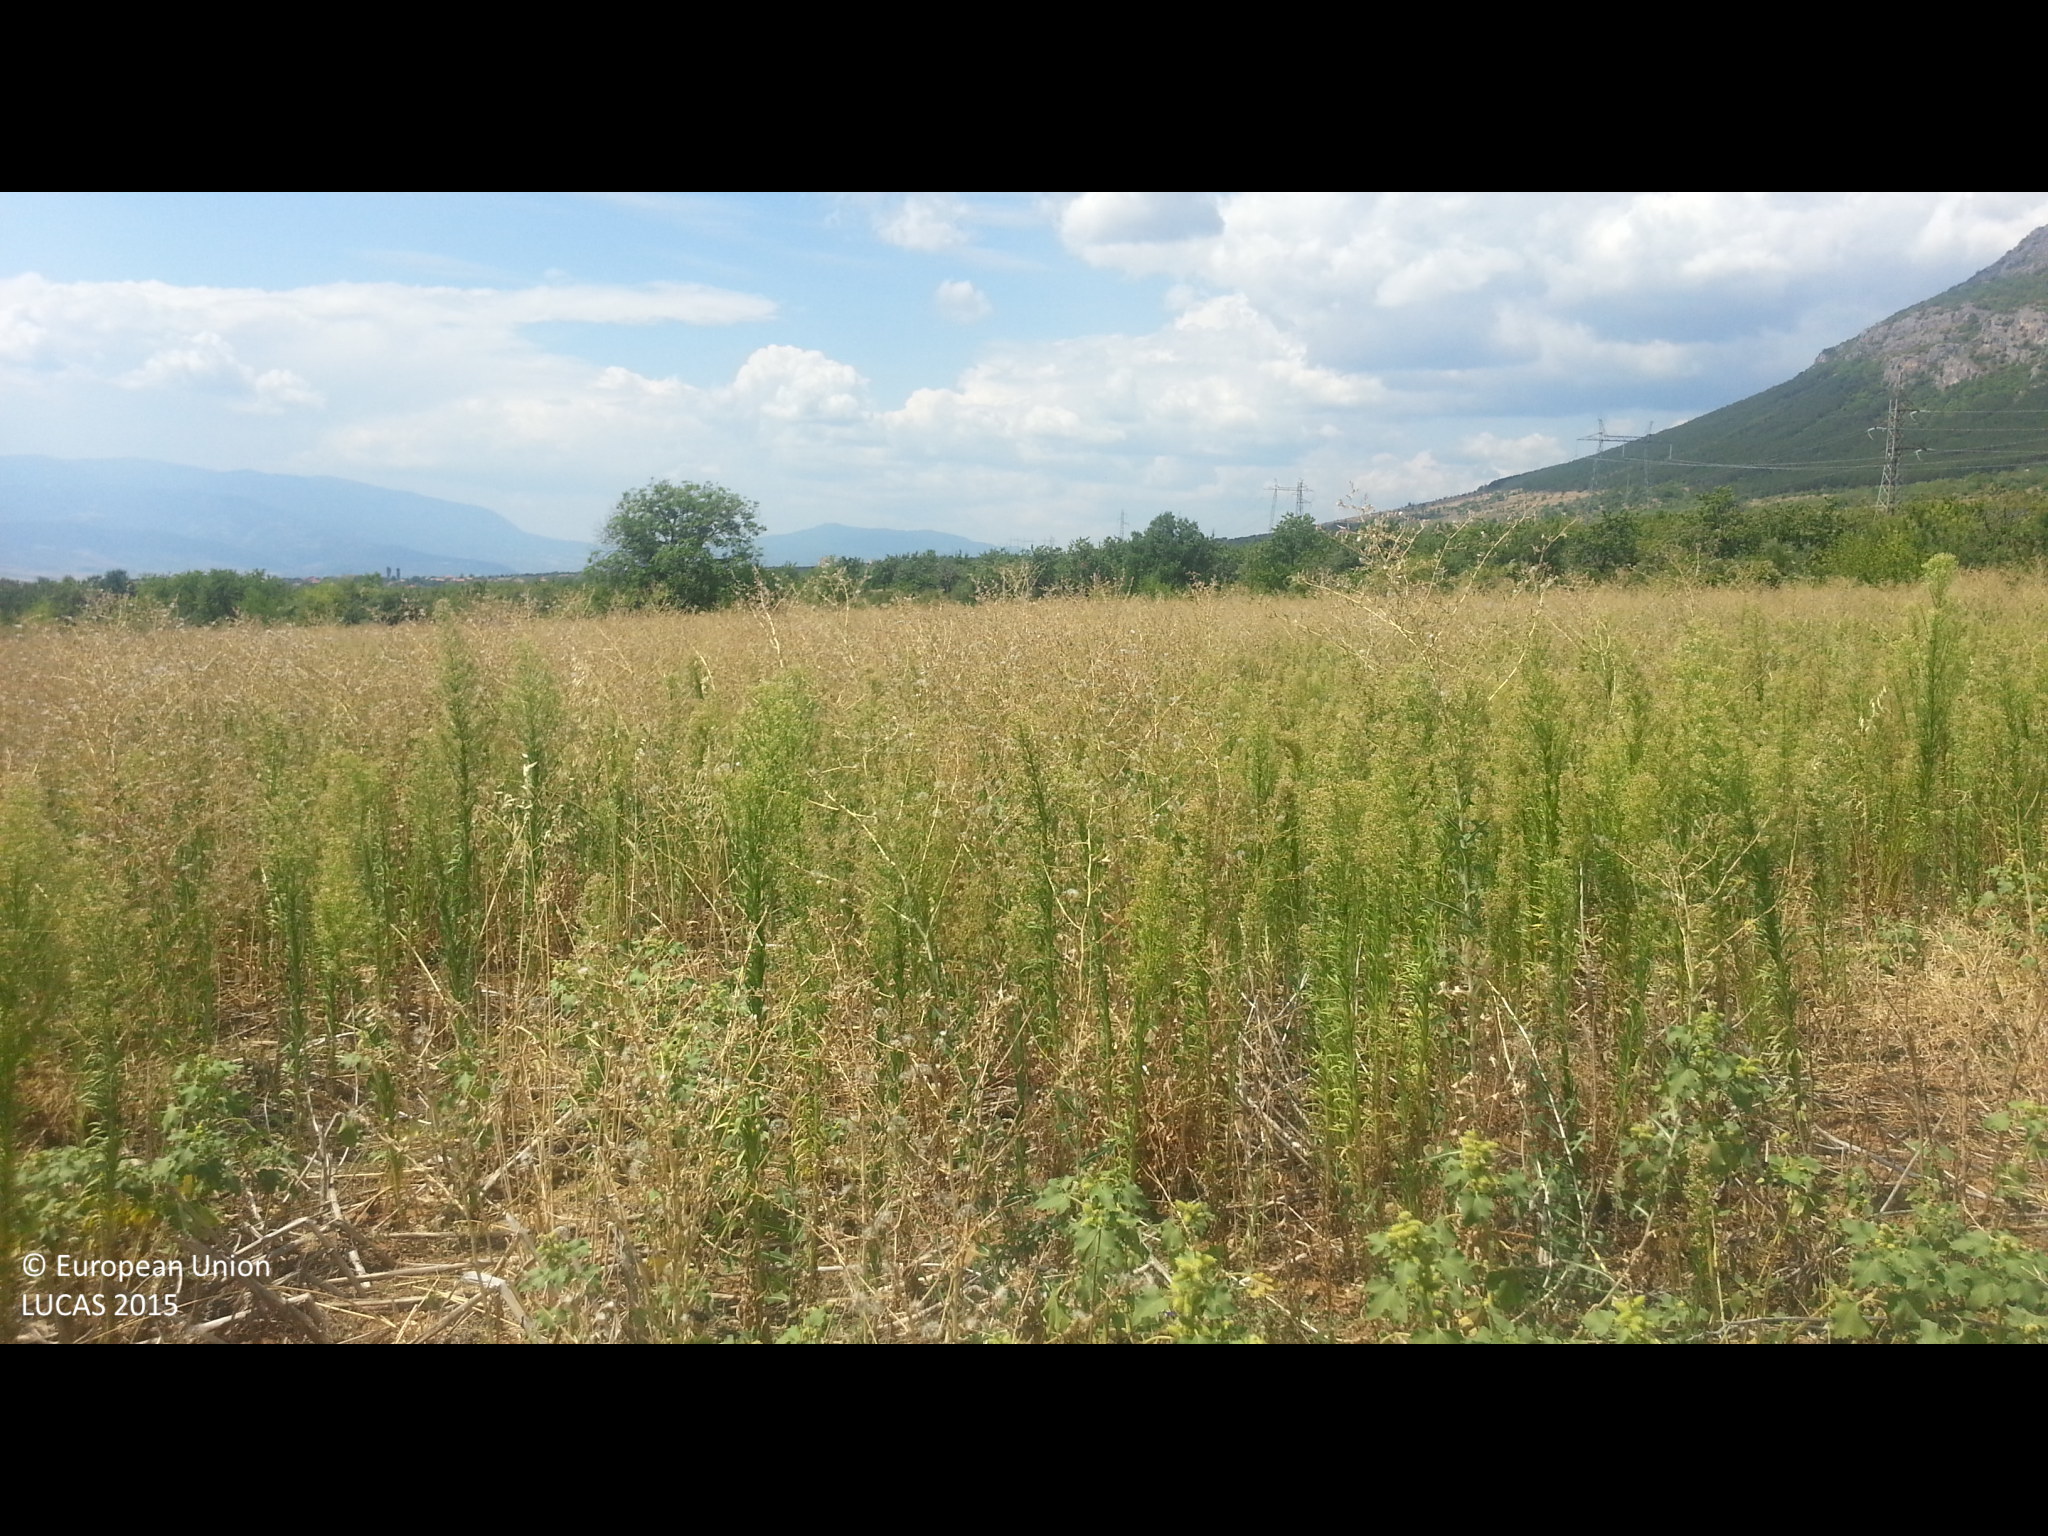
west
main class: Grassland
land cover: Spontaneously vegetated surfaces
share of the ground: > 75 %
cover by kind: herbaceous plants 95 %, unconsolidated bare surface 5 %
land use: Abandoned areas
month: August
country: BG
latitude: 42.3218
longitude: 22.8745
